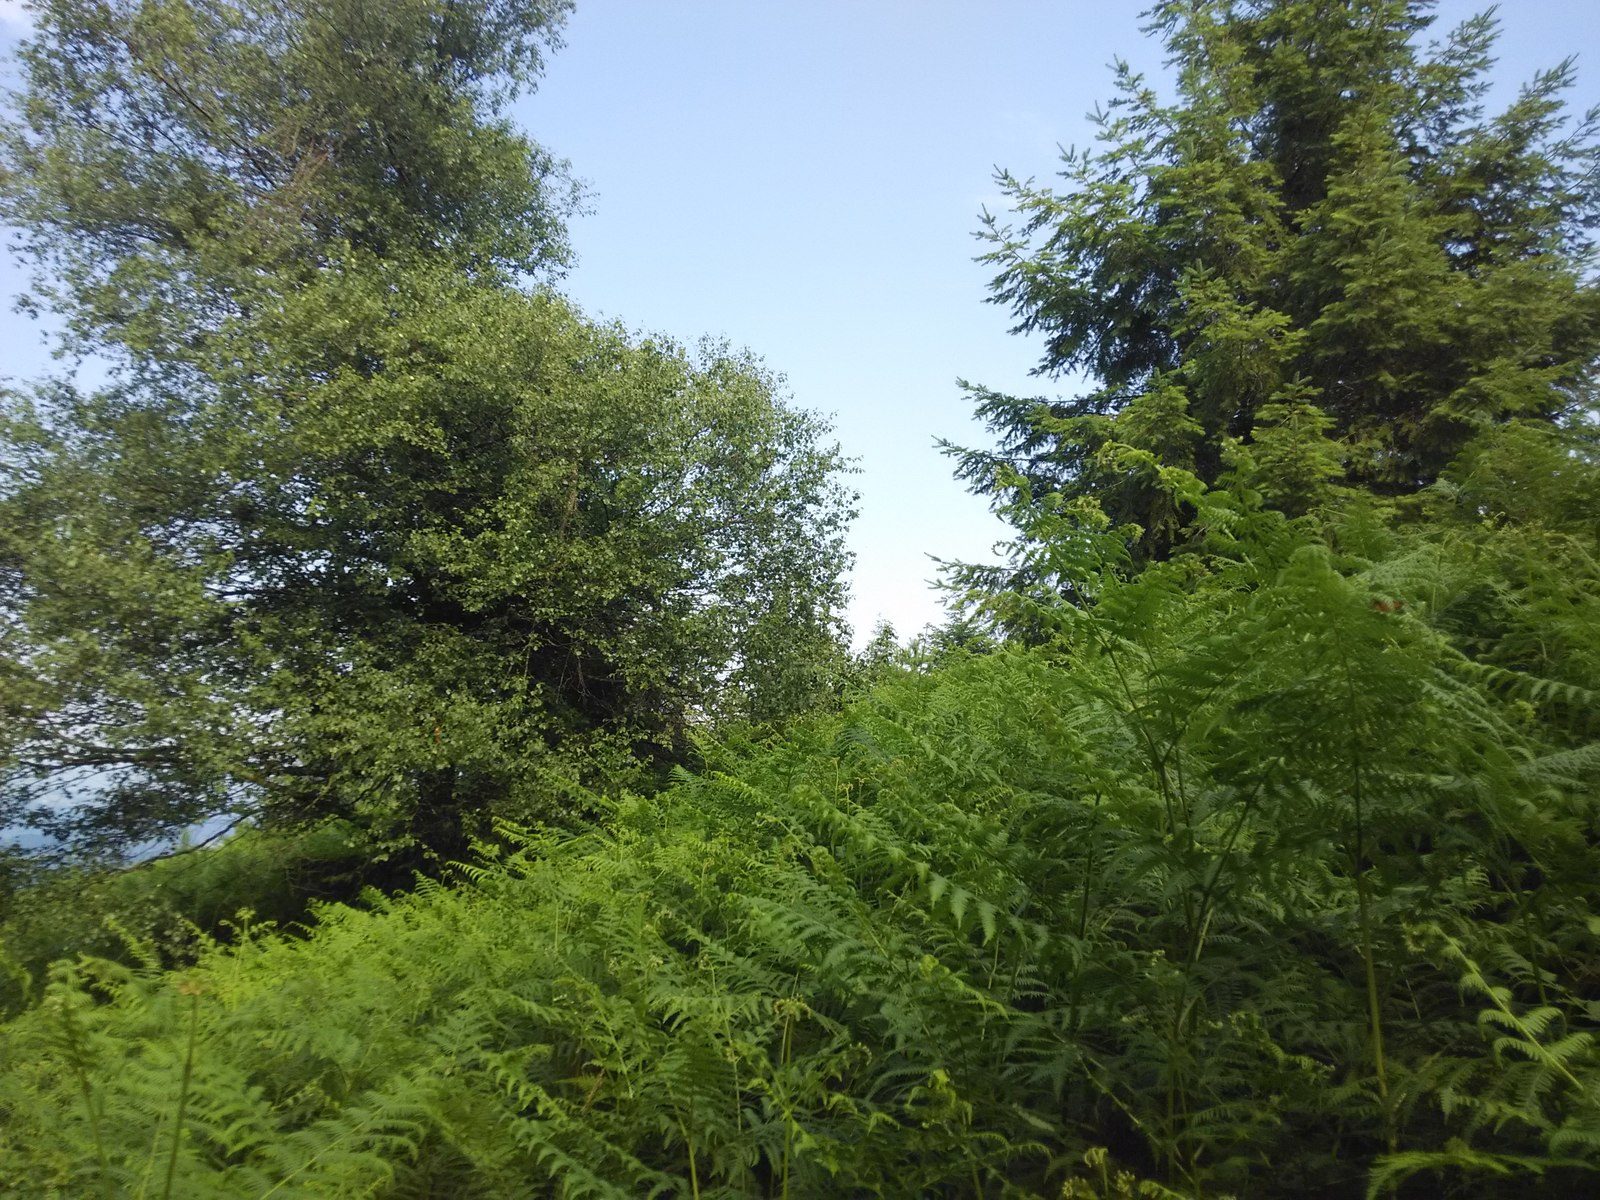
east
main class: Grassland
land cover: Grassland with sparse tree/shrub cover
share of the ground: > 75 %
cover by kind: herbaceous plants 95 %, coniferous forest trees 5 %
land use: Semi-natural and natural areas not in use
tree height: > 5 m
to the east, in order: Grassland with sparse tree/shrub cover; Grassland without tree/shrub cover; Grassland with sparse tree/shrub cover; Grassland without tree/shrub cover; Fences; Pine dominated coniferous woodland
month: June
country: ES
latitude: 43.0312
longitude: -2.3092
